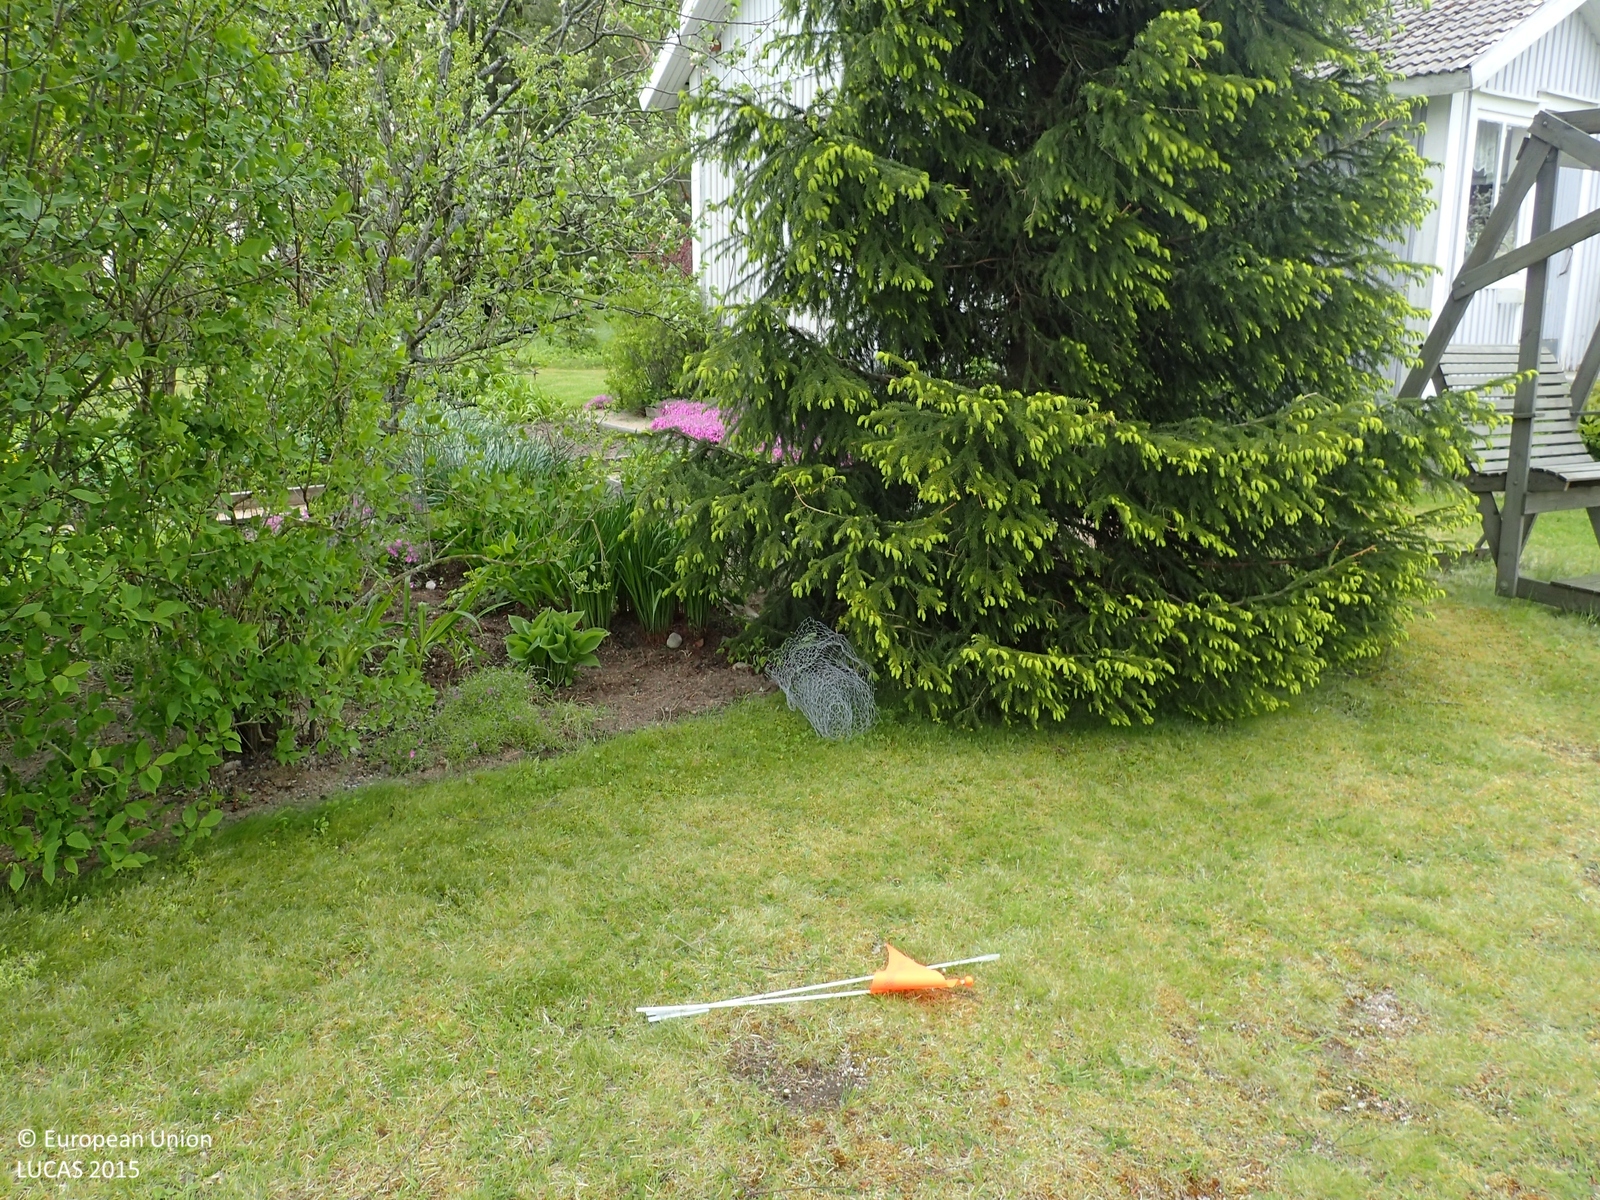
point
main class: Woodland
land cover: Spruce dominated mixed woodland
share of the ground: 10 - 25 %
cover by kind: herbaceous plants 65 %, coniferous forest trees 5 %, broadleaved forest trees 5 %
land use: Residential
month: June
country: FI
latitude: 62.2672
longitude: 21.6623
